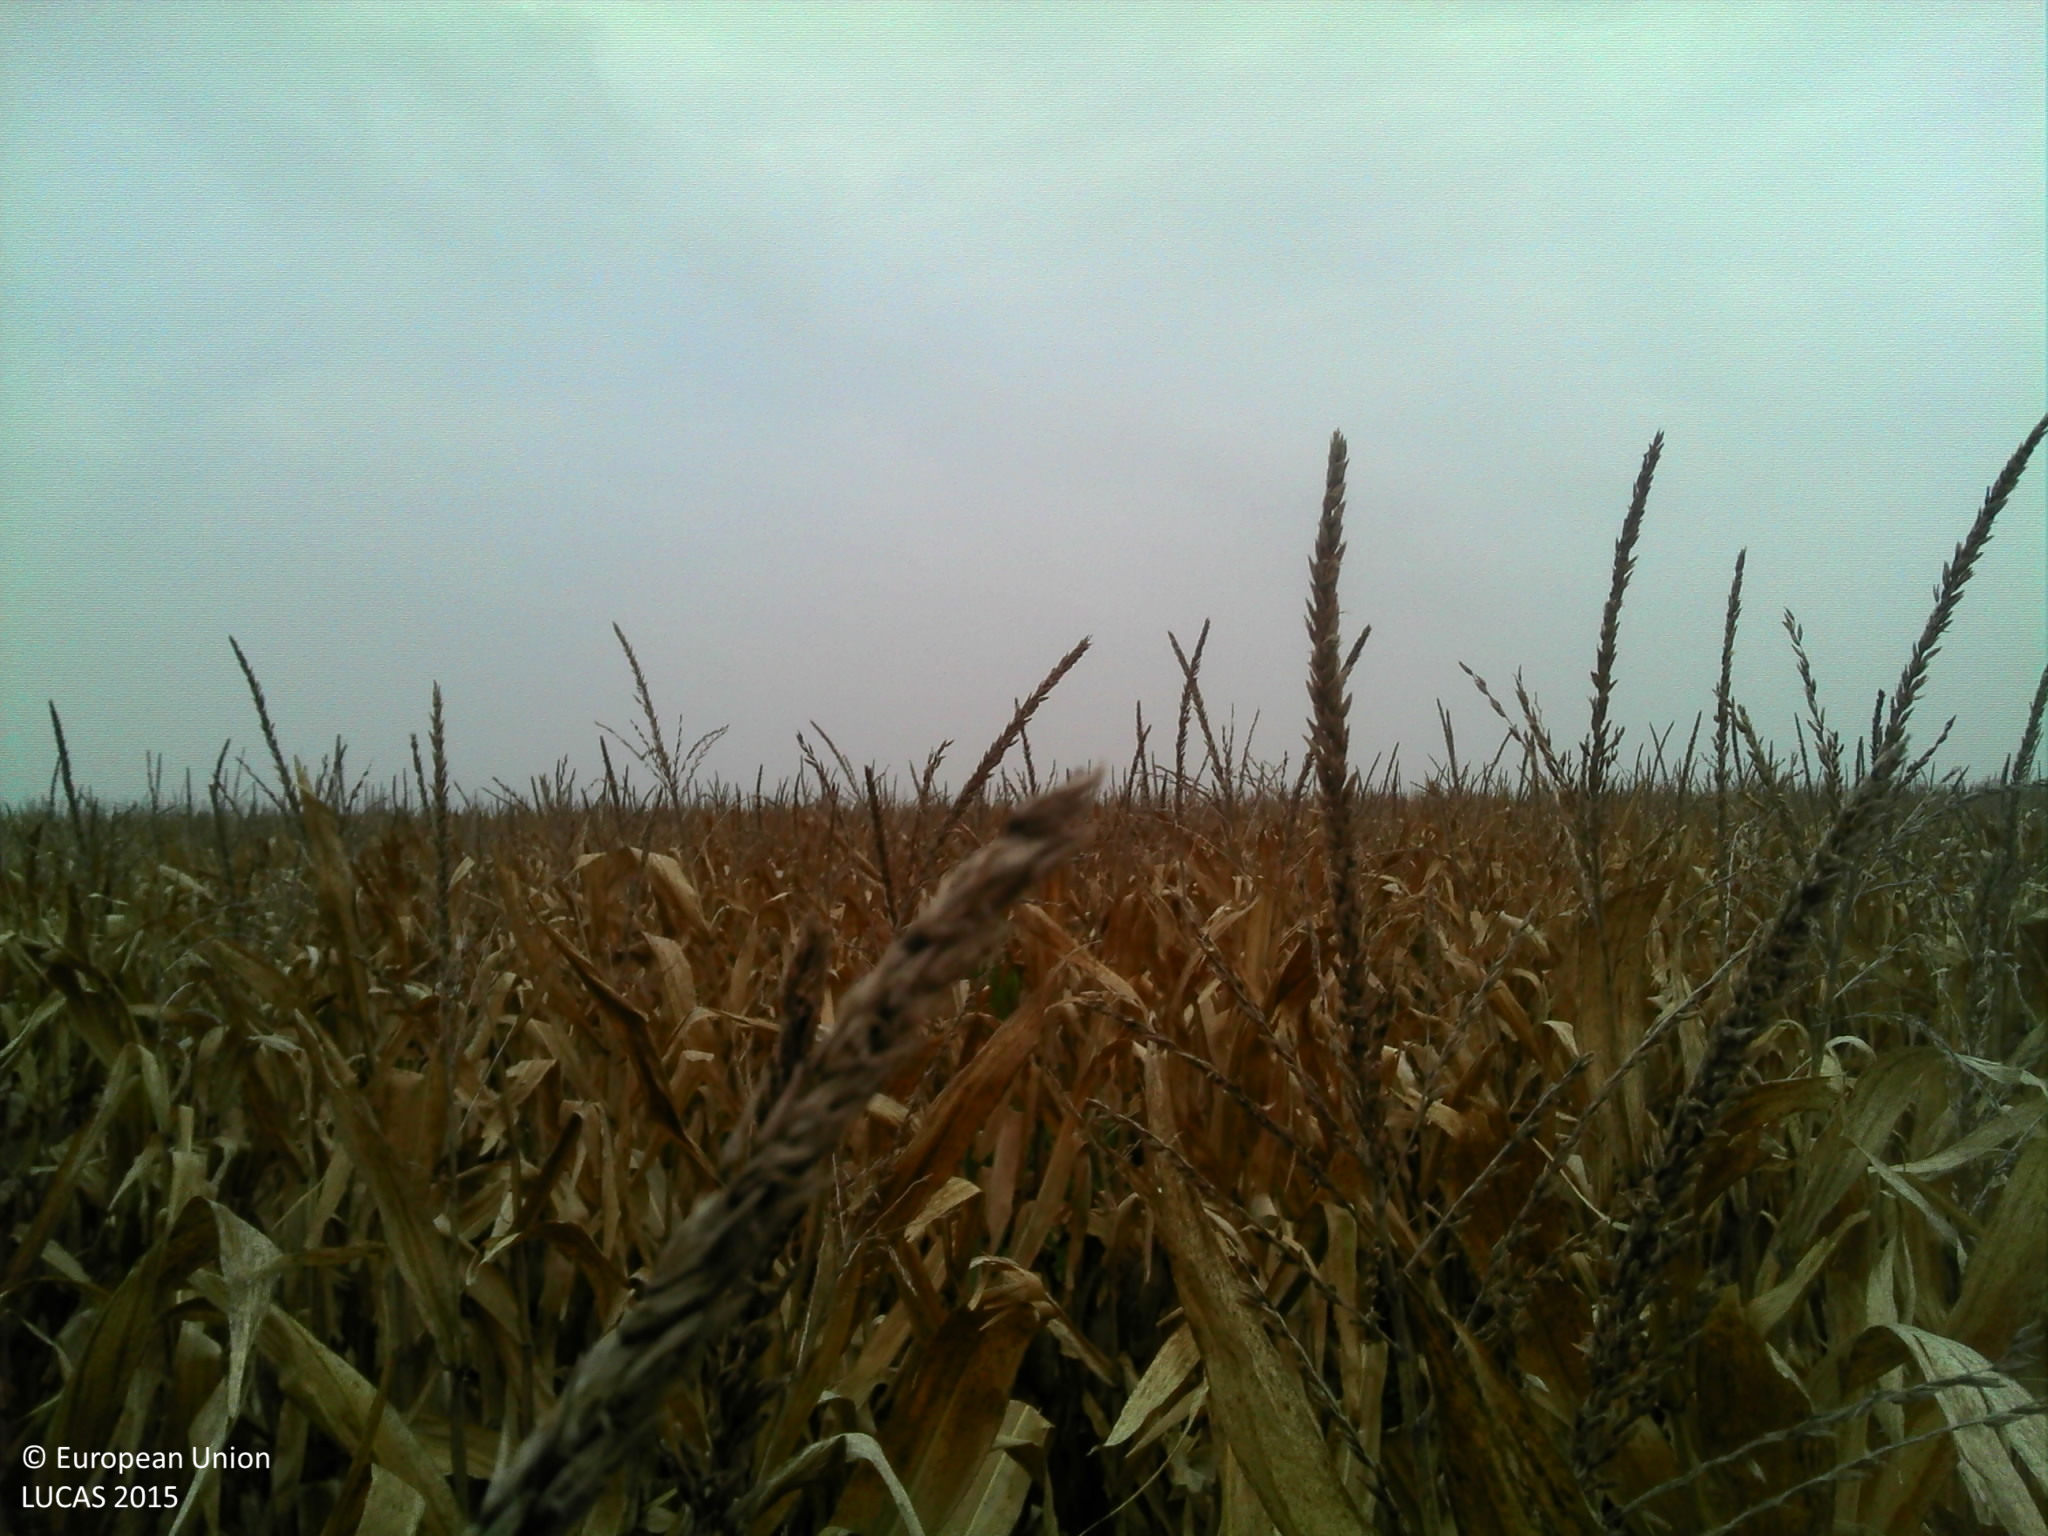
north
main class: Cropland
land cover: Maize
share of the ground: 25 - 50 %
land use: Agriculture (excluding fallow land and kitchen gardens)
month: October
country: FR
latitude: 46.4536
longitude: -1.0069
